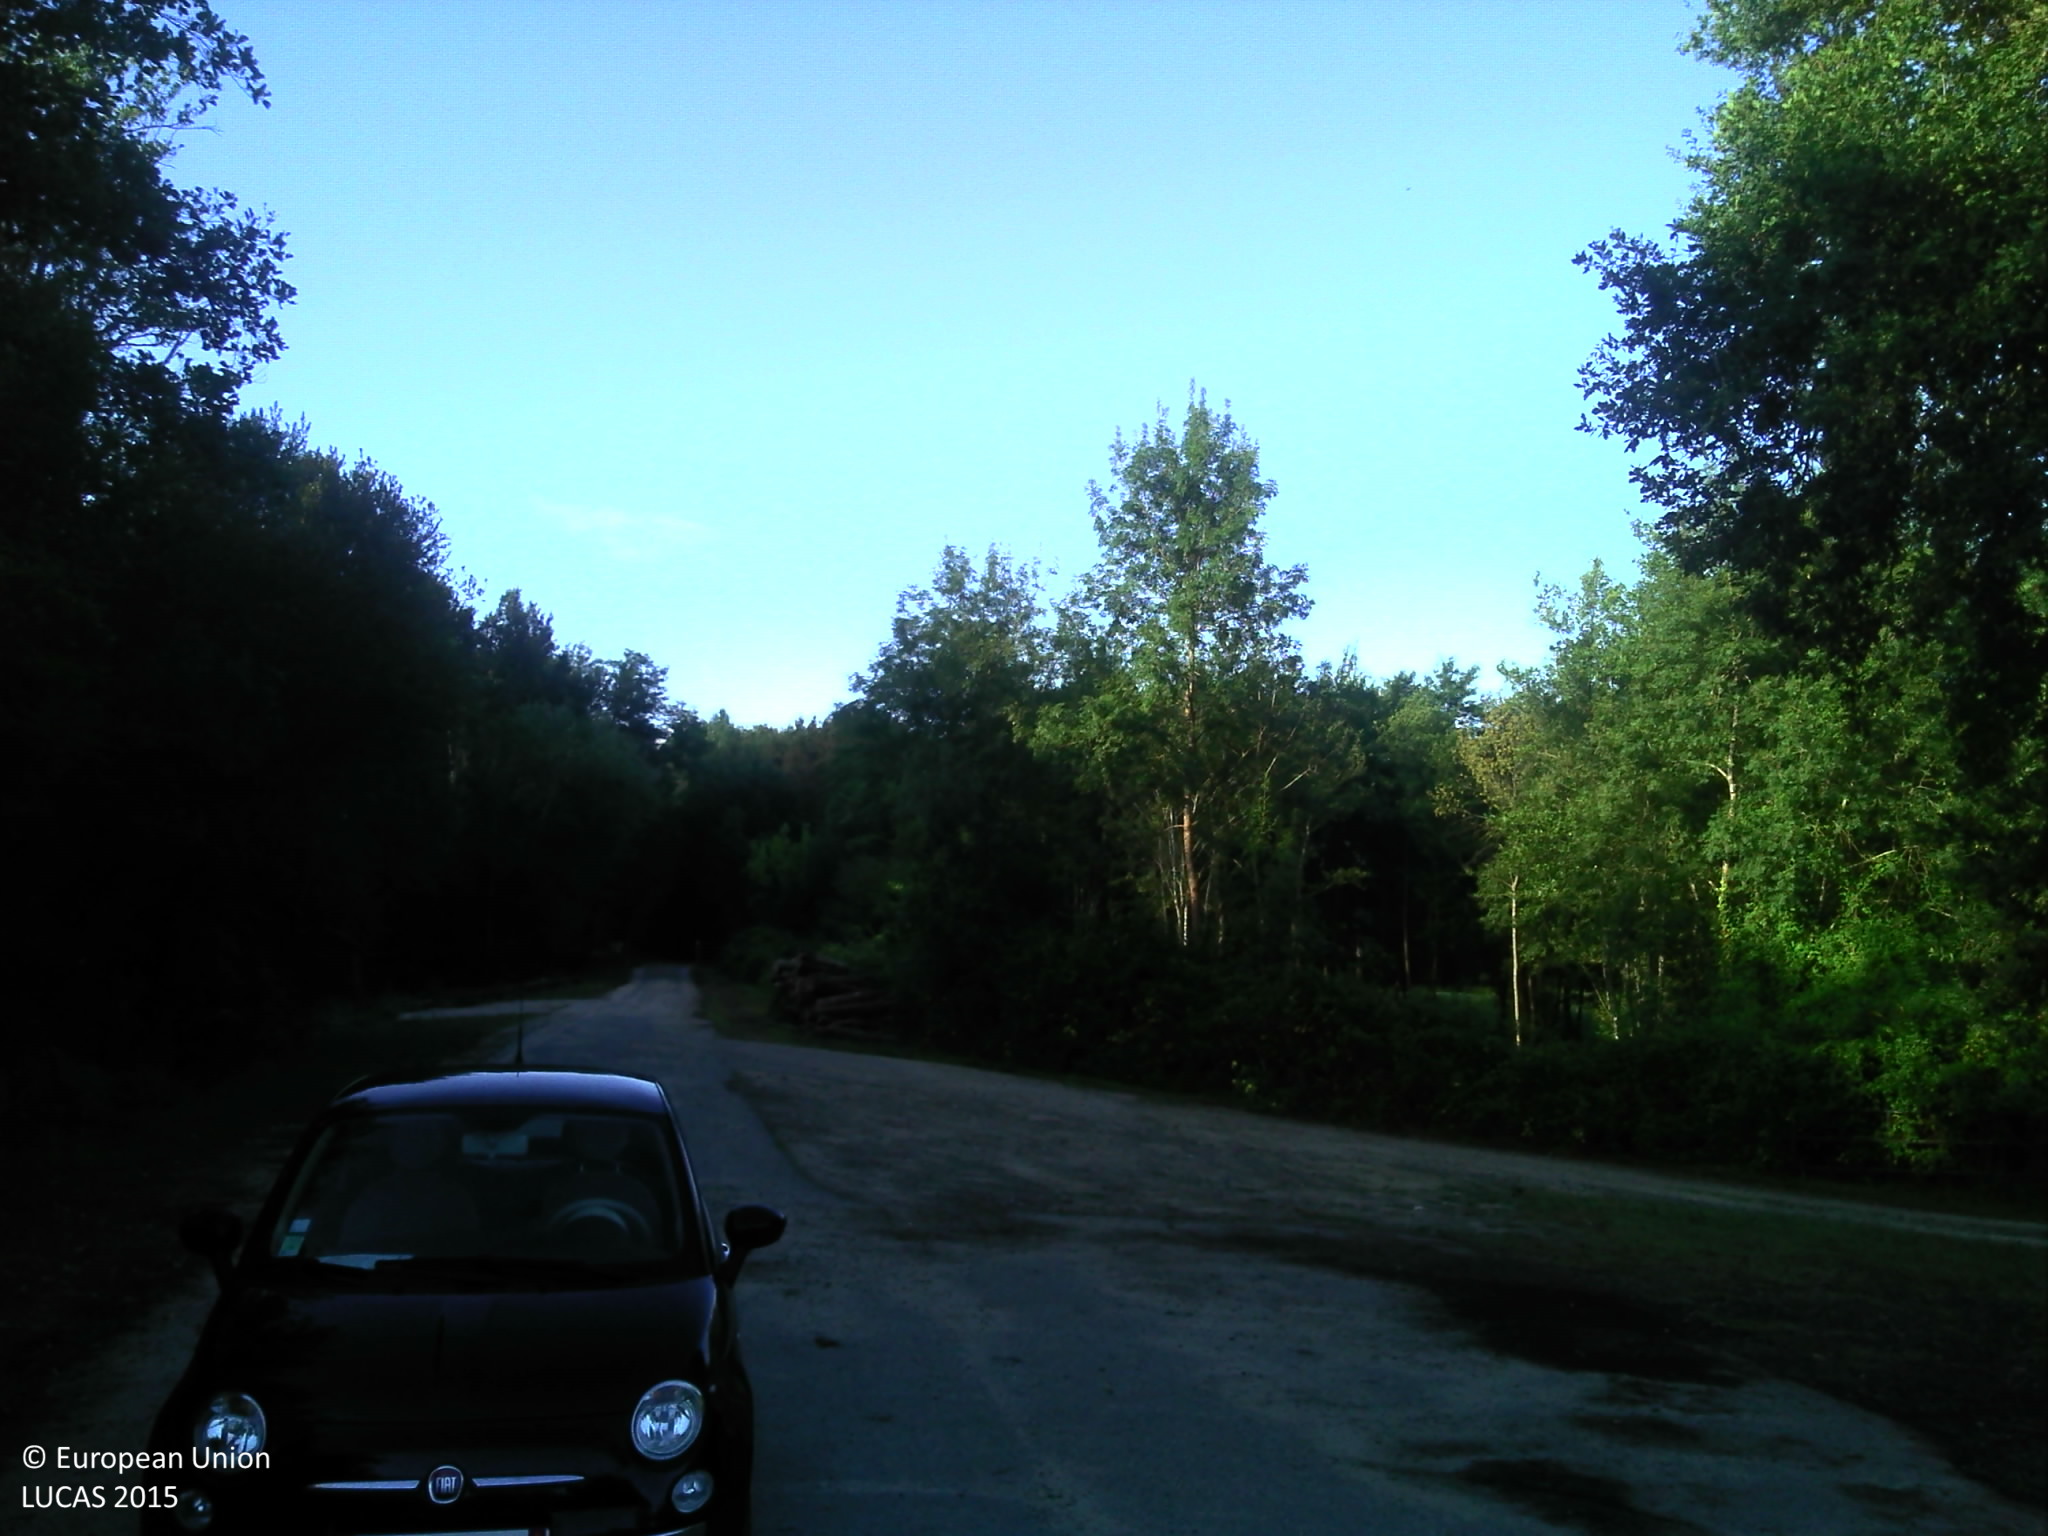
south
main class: Woodland
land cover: Broadleaved woodland
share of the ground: > 75 %
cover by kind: broadleaved forest trees 85 %, herbaceous plants 10 %, lichens and mosses 5 %
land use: Semi-natural and natural areas not in use
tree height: > 5 m
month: July
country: FR
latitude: 43.6784
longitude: -1.1177
